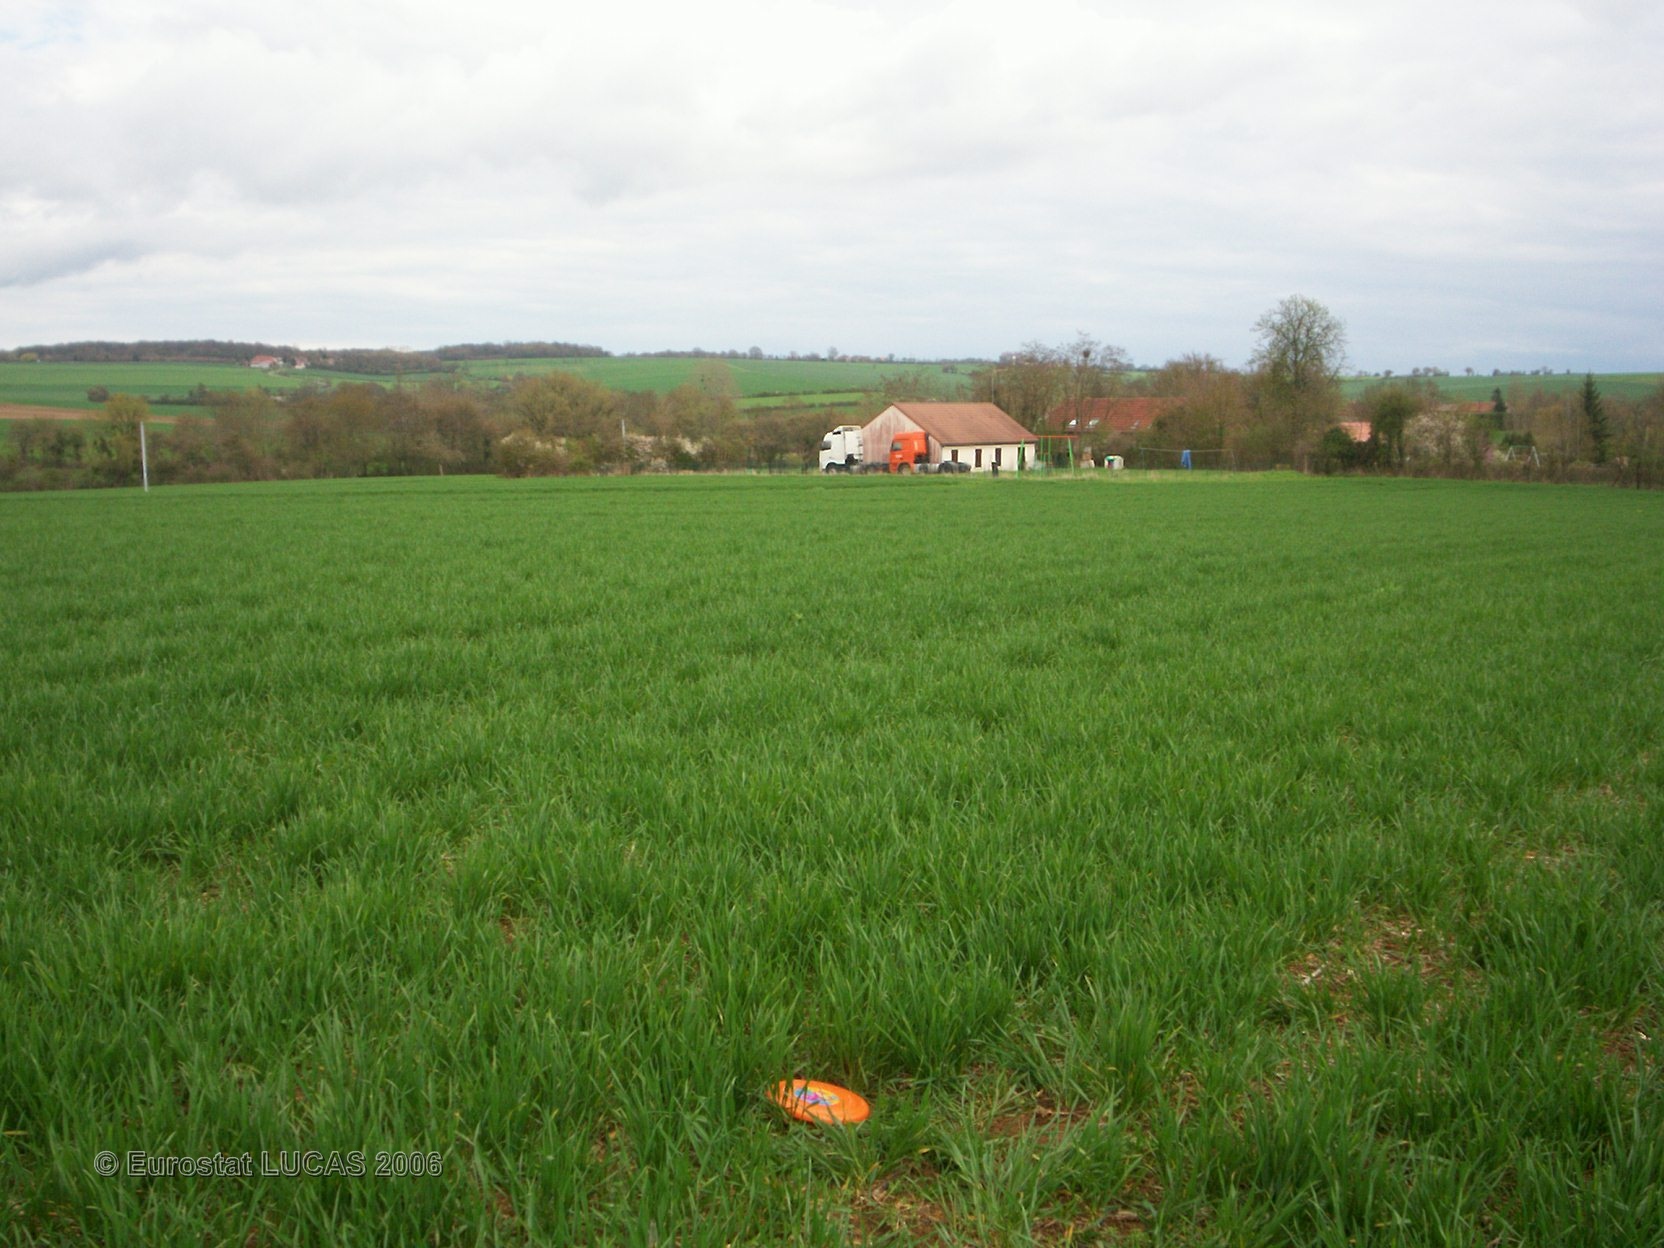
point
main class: Cropland
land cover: Common wheat
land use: Agriculture (excluding fallow land and kitchen gardens)
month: April
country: FR
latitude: 47.4414
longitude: 3.0062
